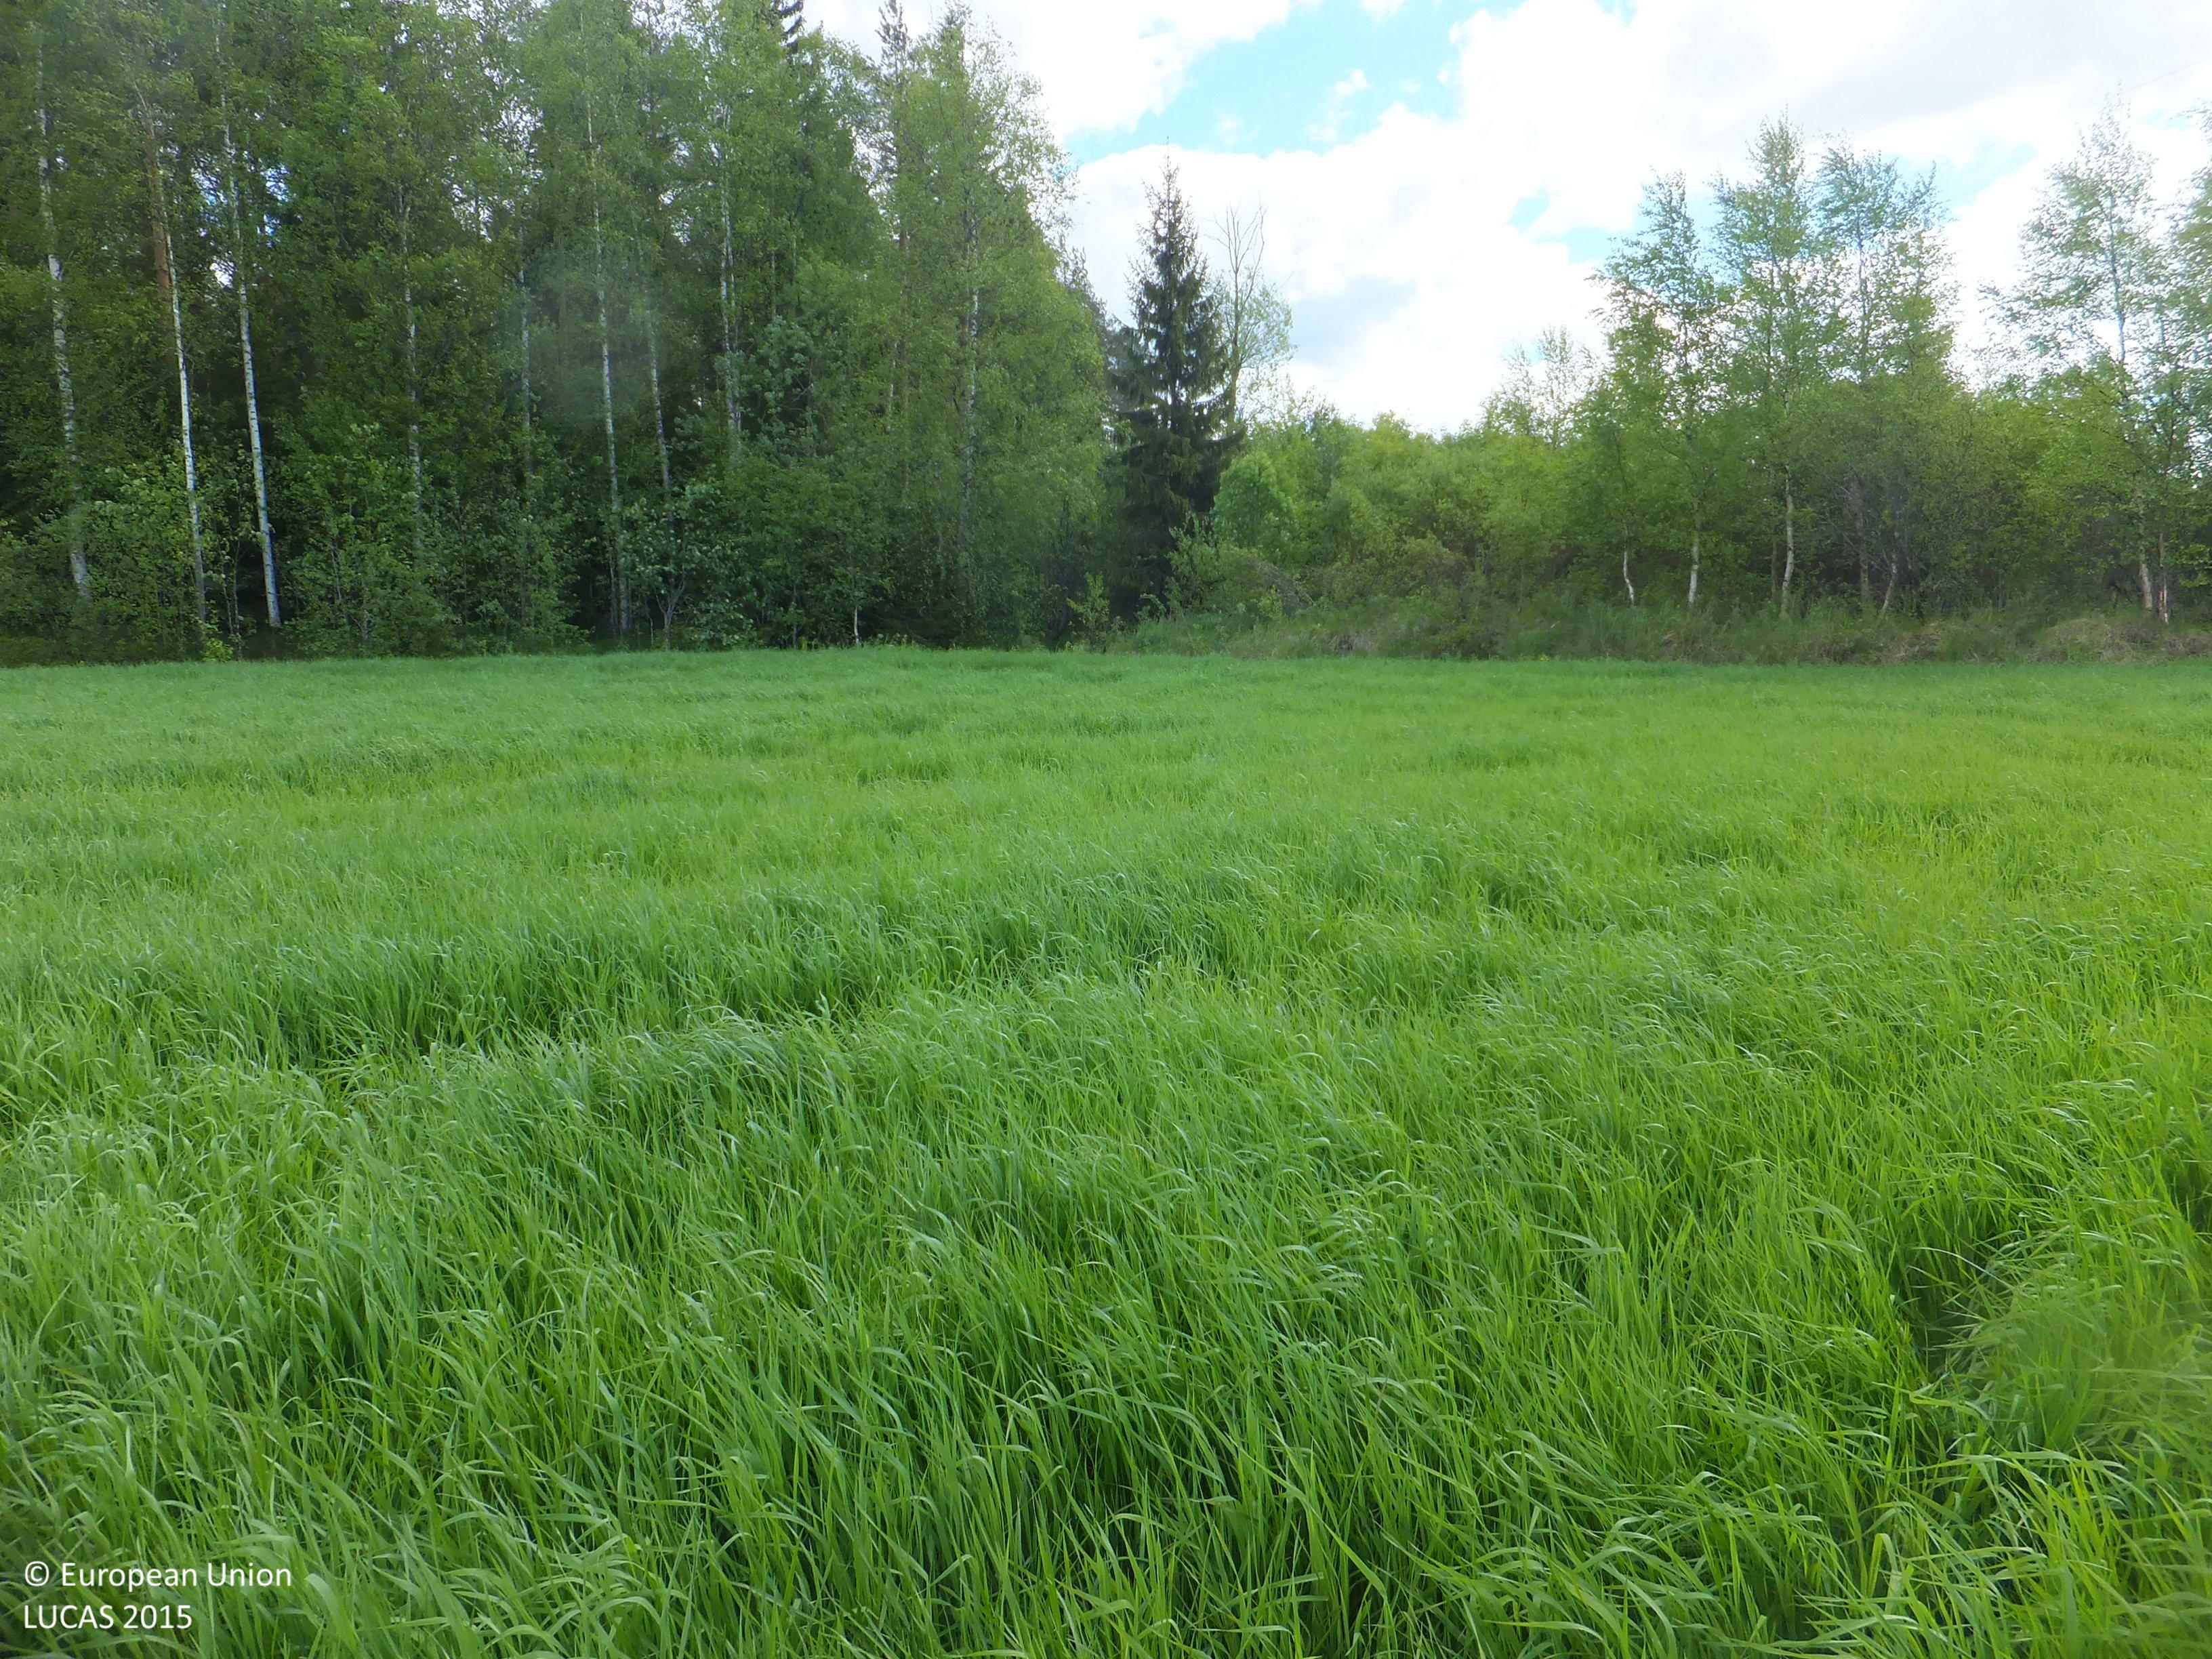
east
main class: Cropland
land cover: Temporary grasslands
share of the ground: > 75 %
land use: Agriculture (excluding fallow land and kitchen gardens)
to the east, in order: Temporary grasslands; Grass margins; Ditches and canals; Other mixed woodland; Pine dominated coniferous woodland; Ditches and canals; Grass margins; Paved roads, cycling and walking lanes
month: June
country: FI
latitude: 63.5815
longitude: 23.0478
